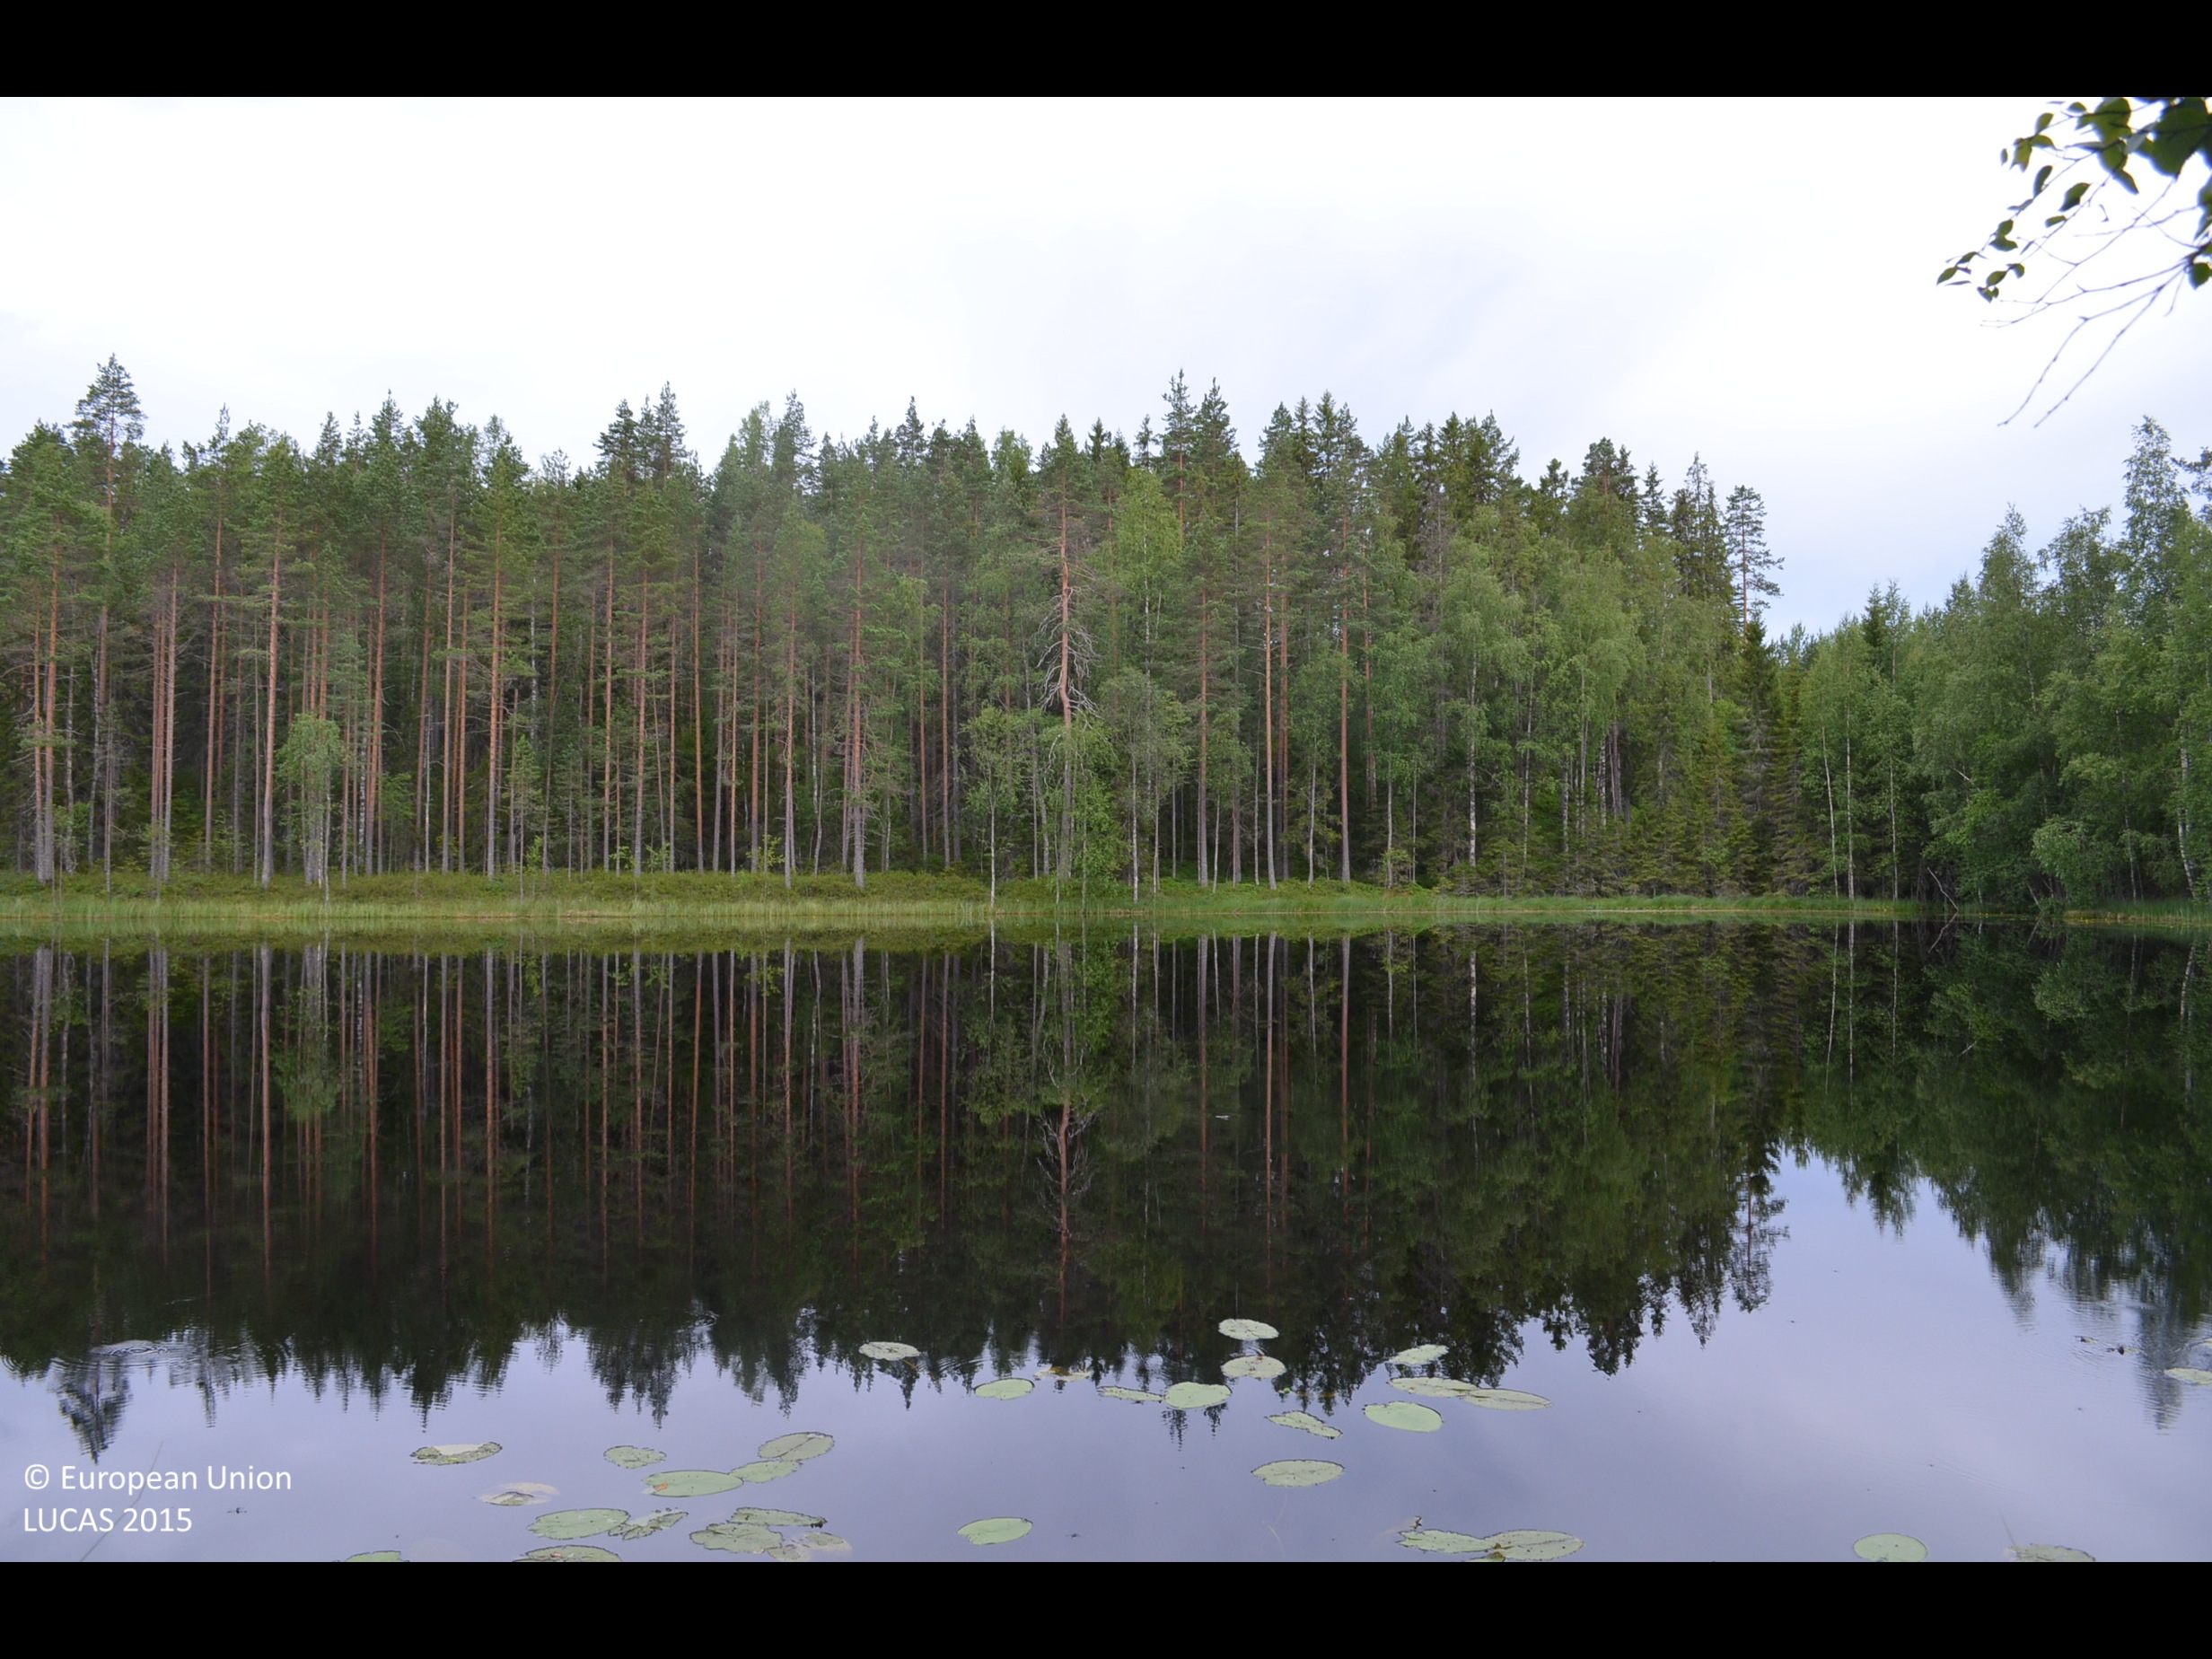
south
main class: Woodland
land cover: Pine dominated coniferous woodland
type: boreal forest
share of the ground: > 75 %
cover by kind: coniferous forest trees 65 %, shrubs 25 %, broadleaved forest trees 10 %
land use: Forestry
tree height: > 5 m
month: July
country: FI
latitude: 62.0294
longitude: 23.9783
